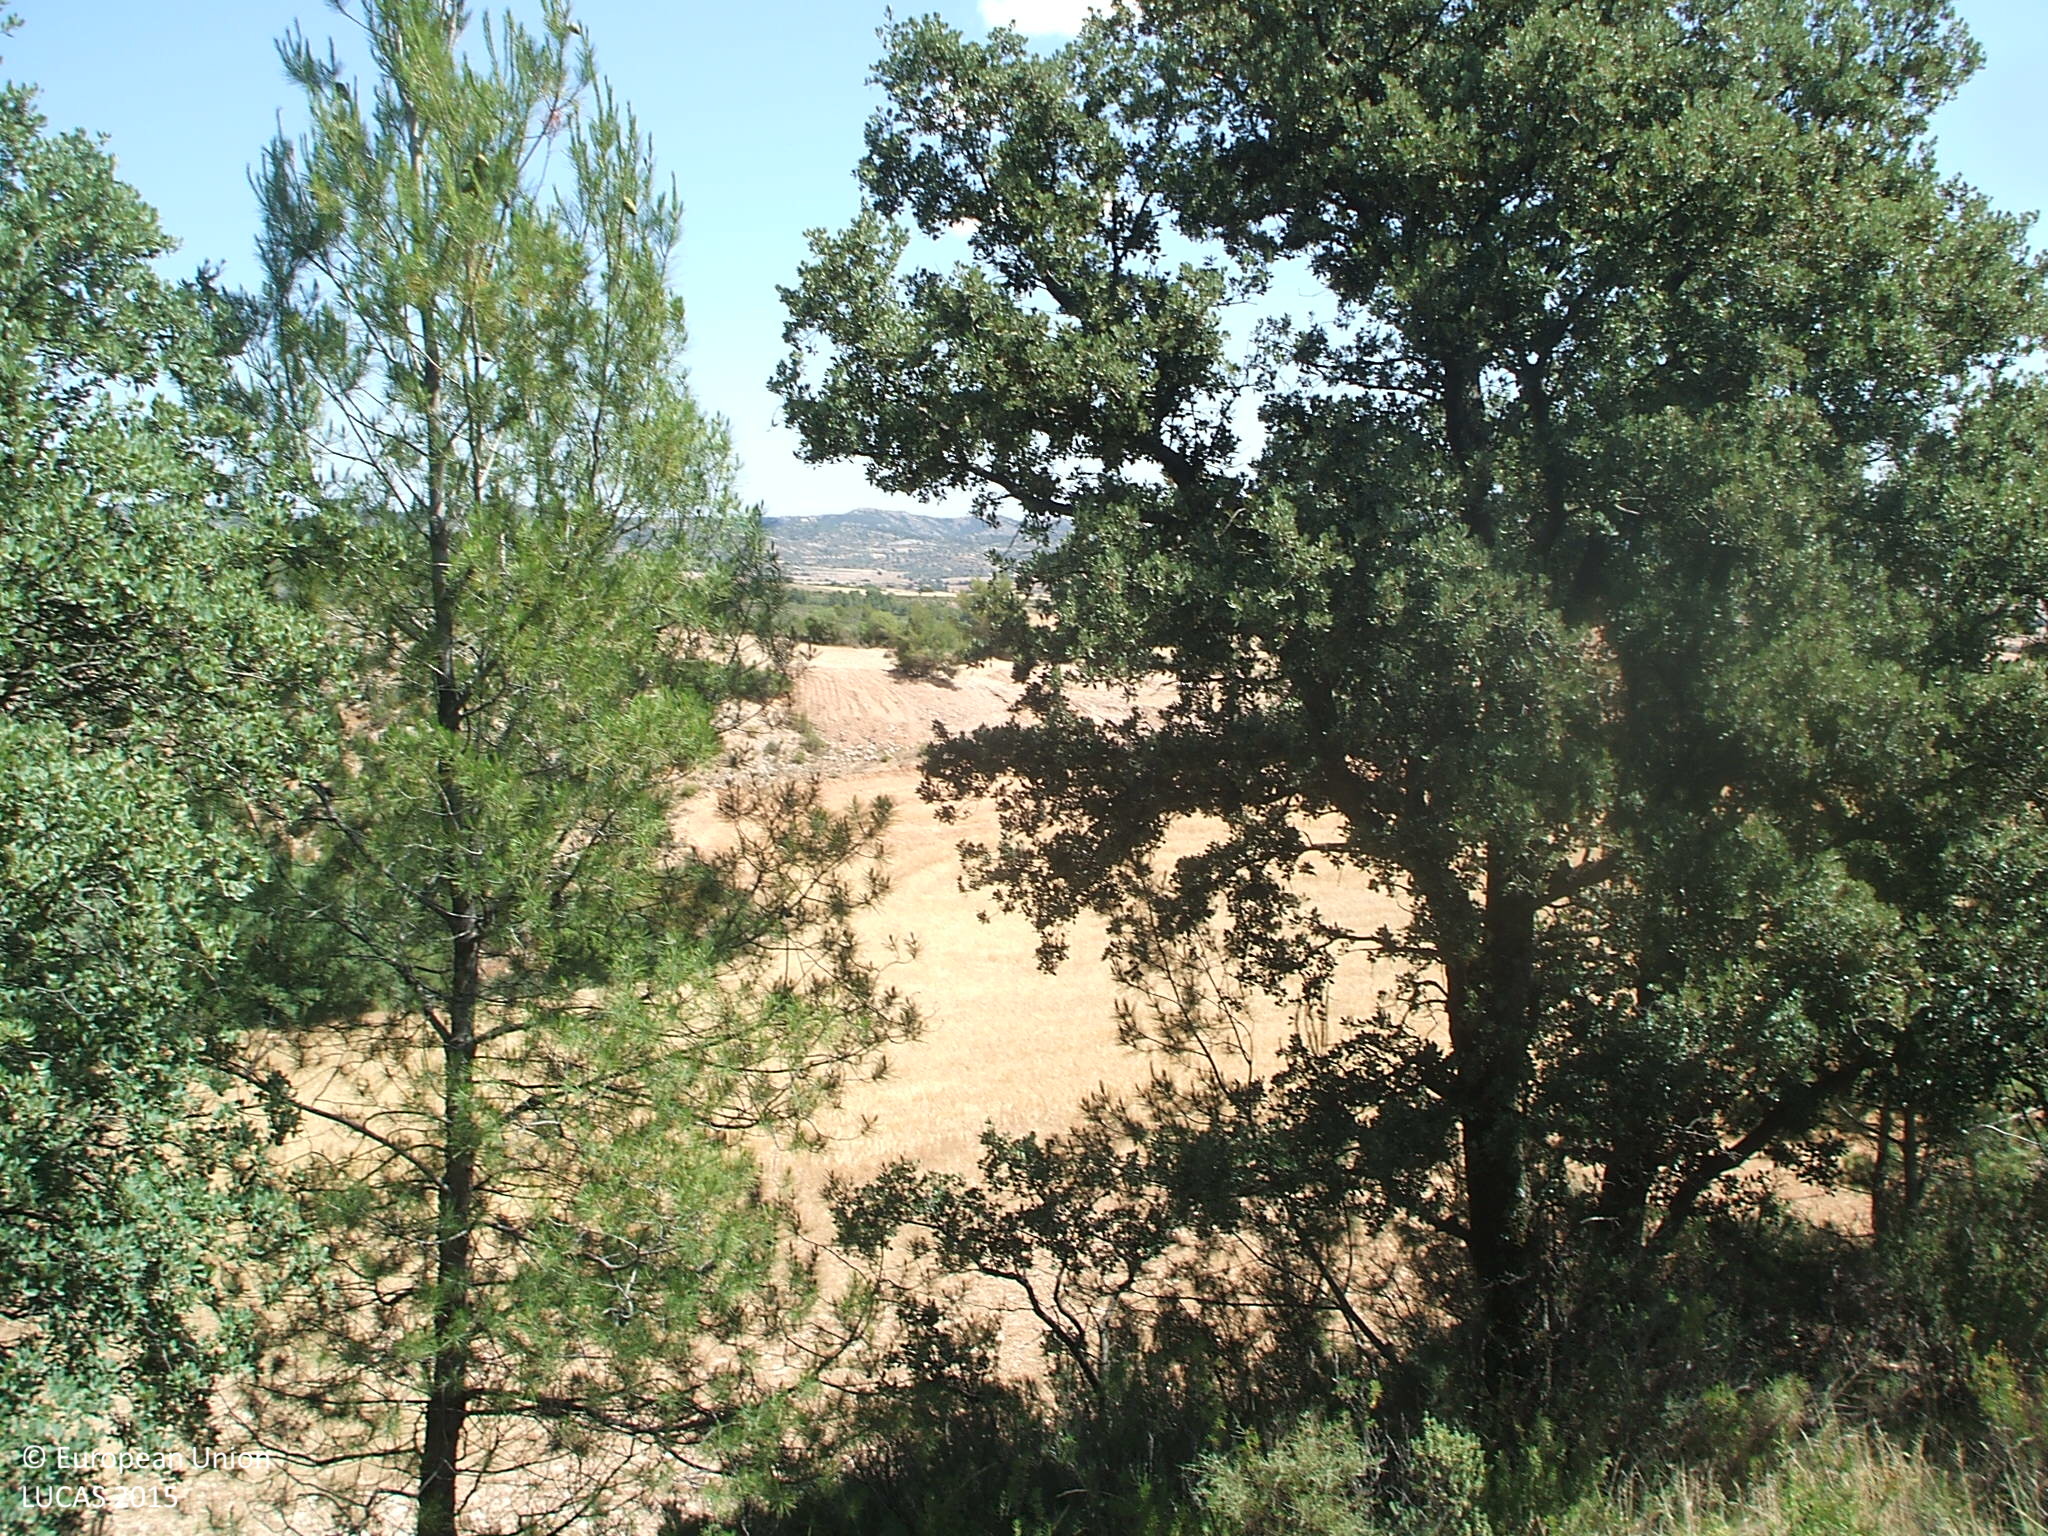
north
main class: Woodland
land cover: Other mixed woodland
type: coniferous forest of the mediterranean region
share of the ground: > 75 %
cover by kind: broadleaved forest trees 50 %, coniferous forest trees 30 %, shrubs 20 %
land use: Semi-natural and natural areas not in use
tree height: > 5 m
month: June
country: ES
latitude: 40.8539
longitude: -0.2952
